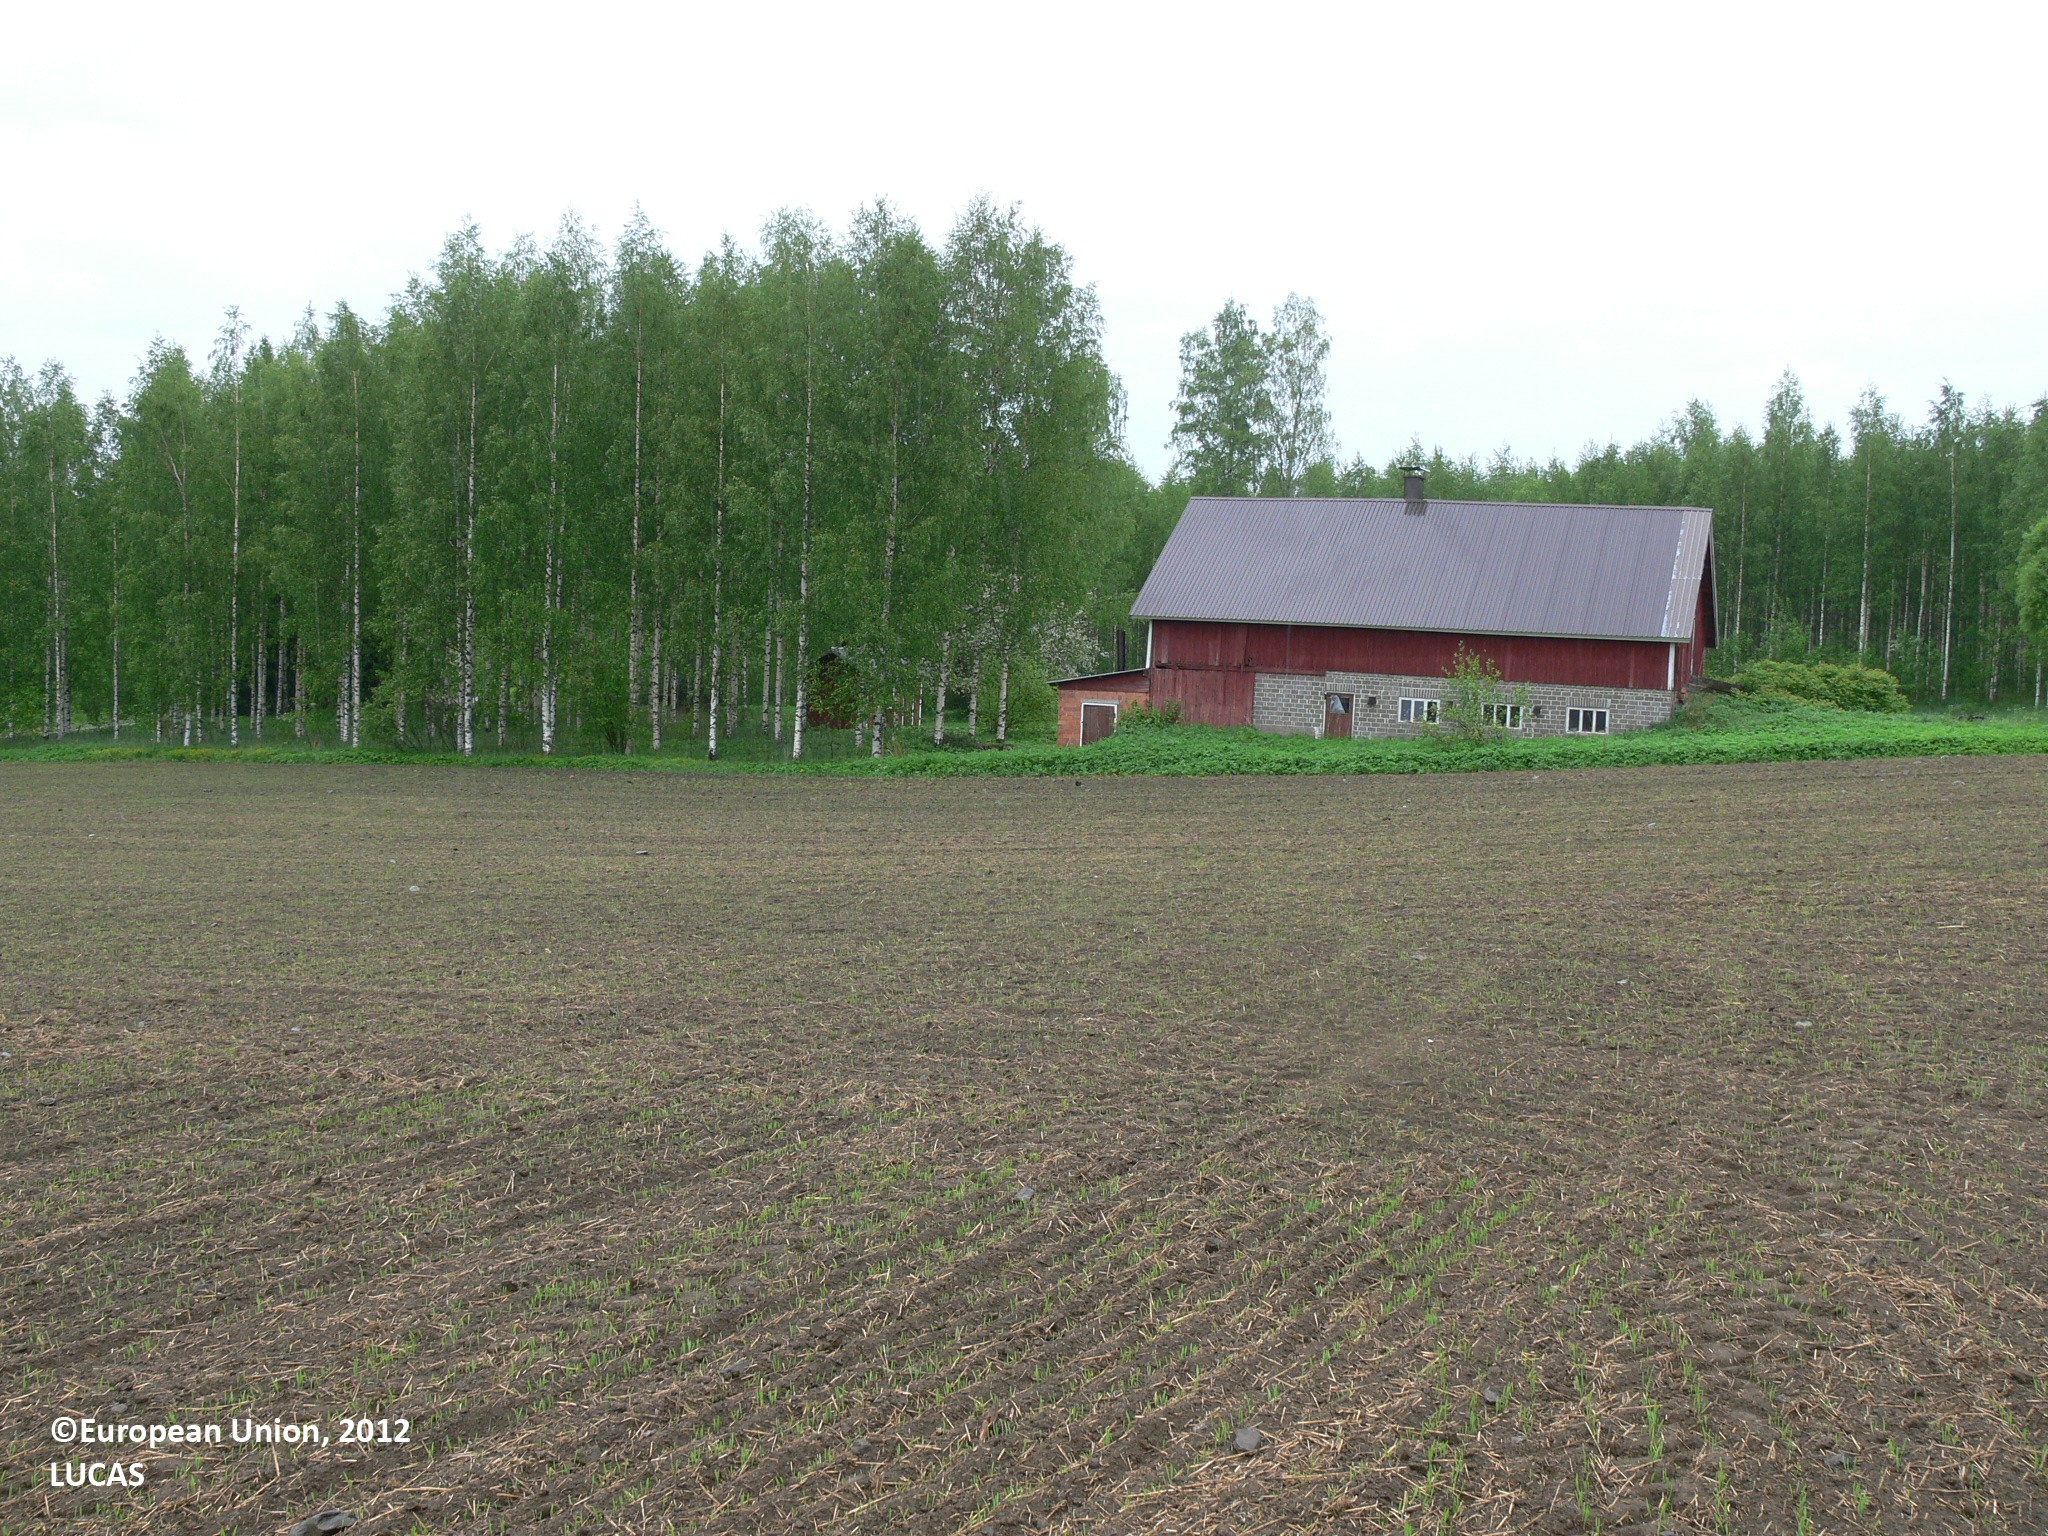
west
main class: Cropland
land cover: Oats
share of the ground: < 10 %
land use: Agriculture (excluding fallow land and kitchen gardens)
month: June
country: FI
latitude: 62.1771
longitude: 30.3089
